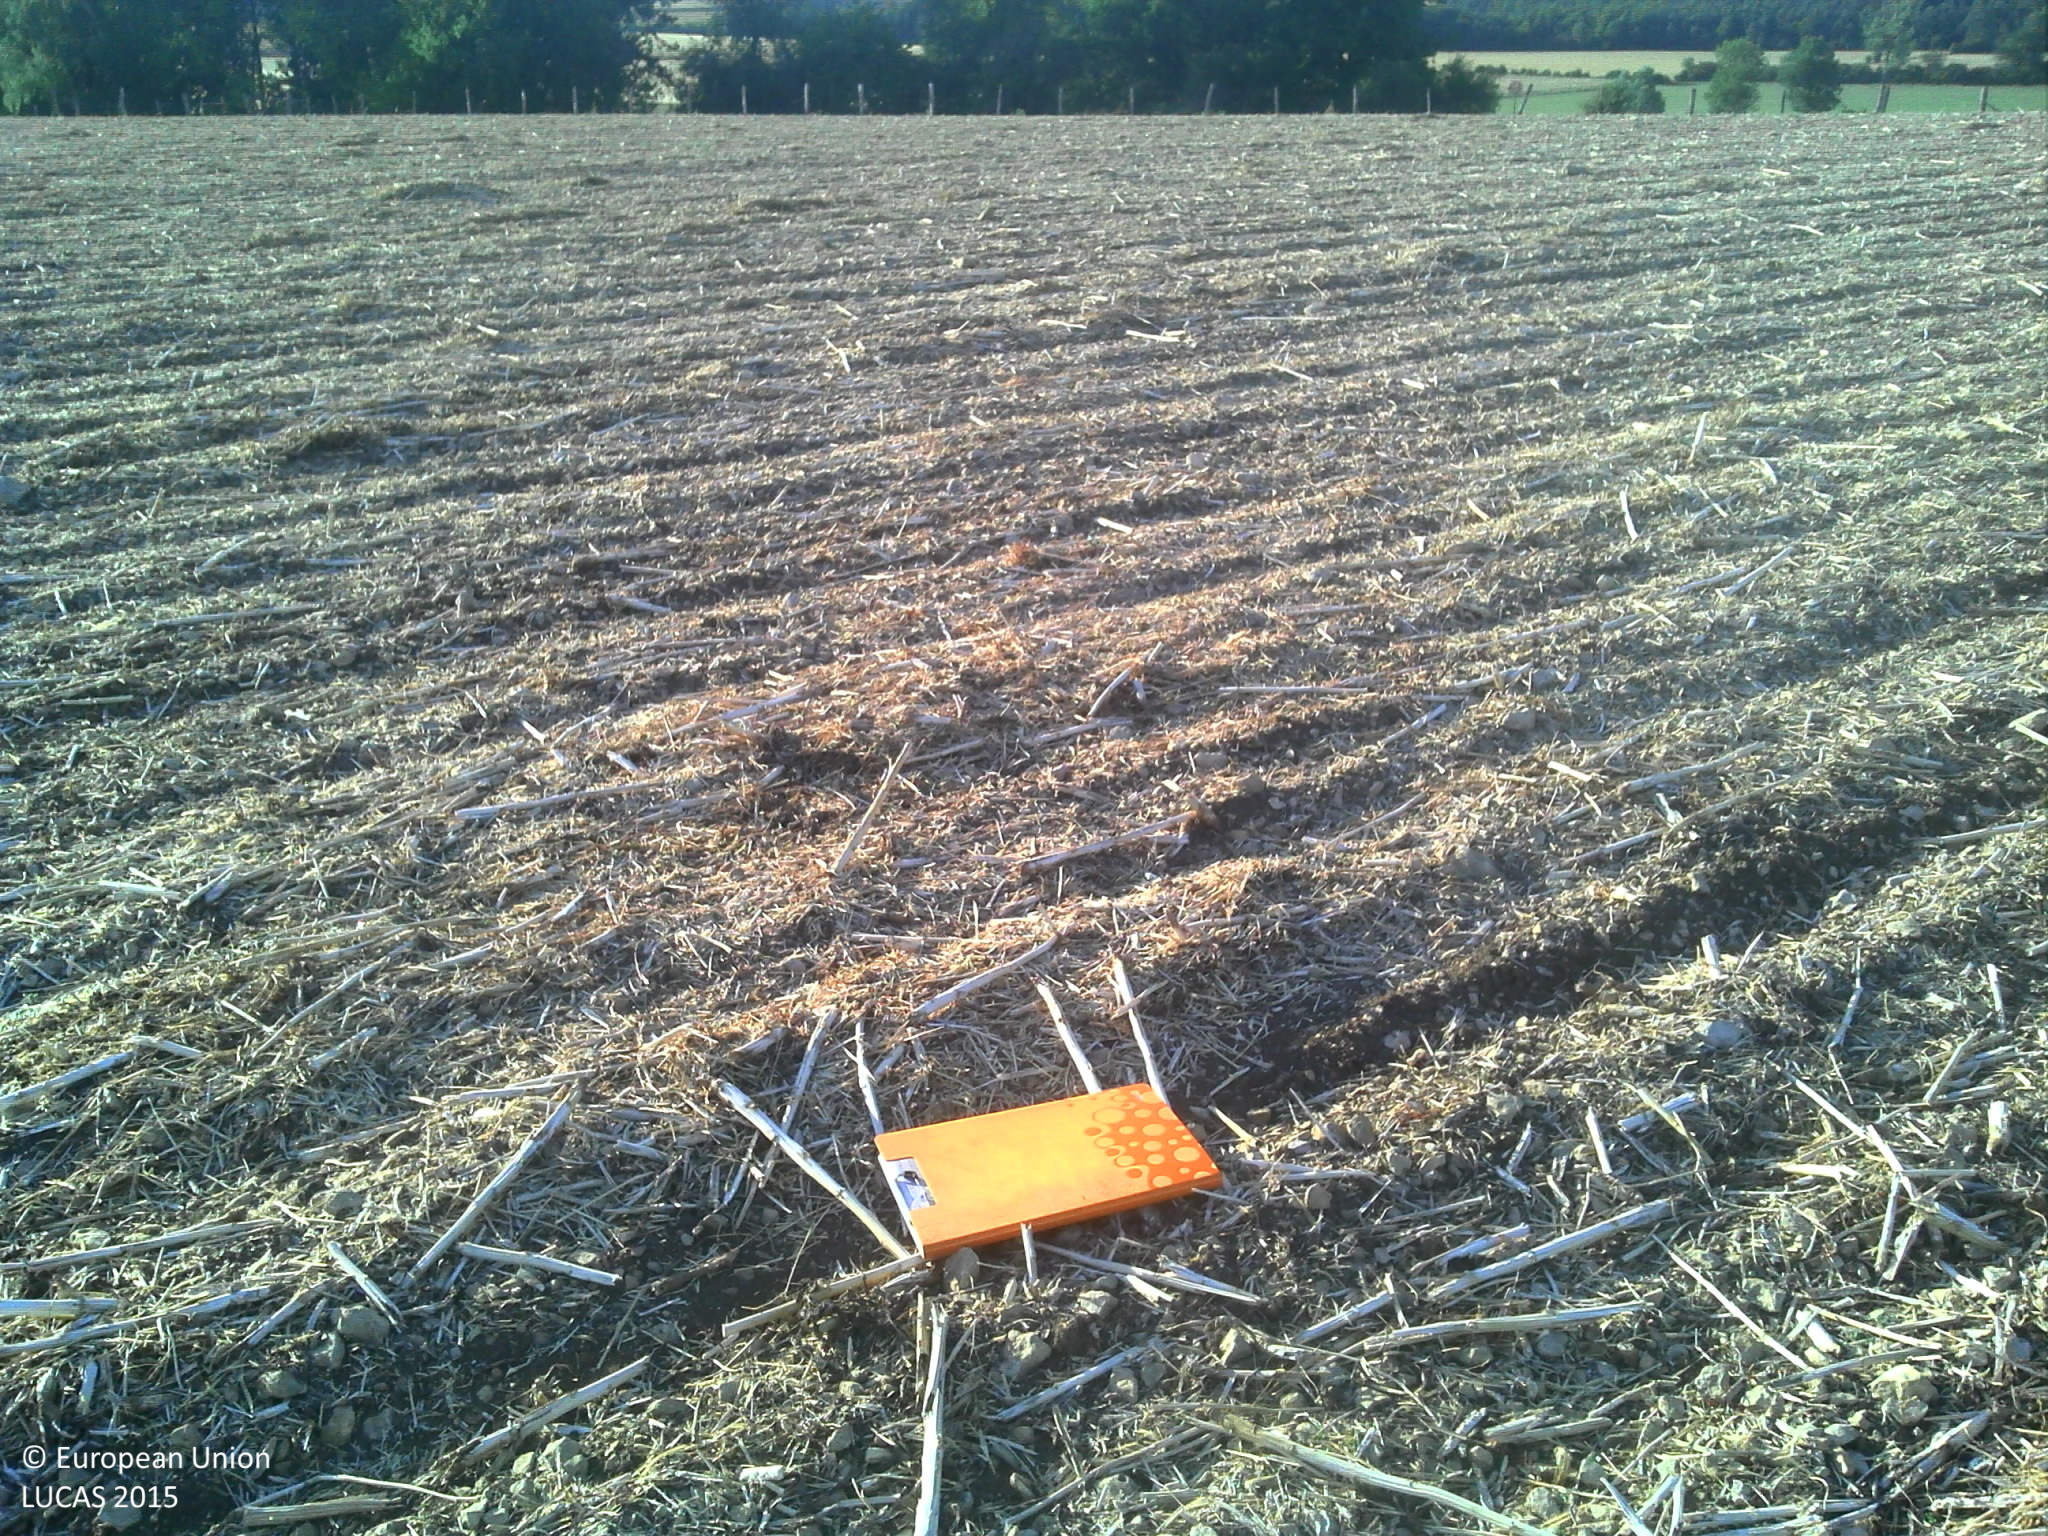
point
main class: Cropland
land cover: Rape and turnip rape
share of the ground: < 10 %
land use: Agriculture (excluding fallow land and kitchen gardens)
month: July
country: FR
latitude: 47.6176
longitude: 5.2771
